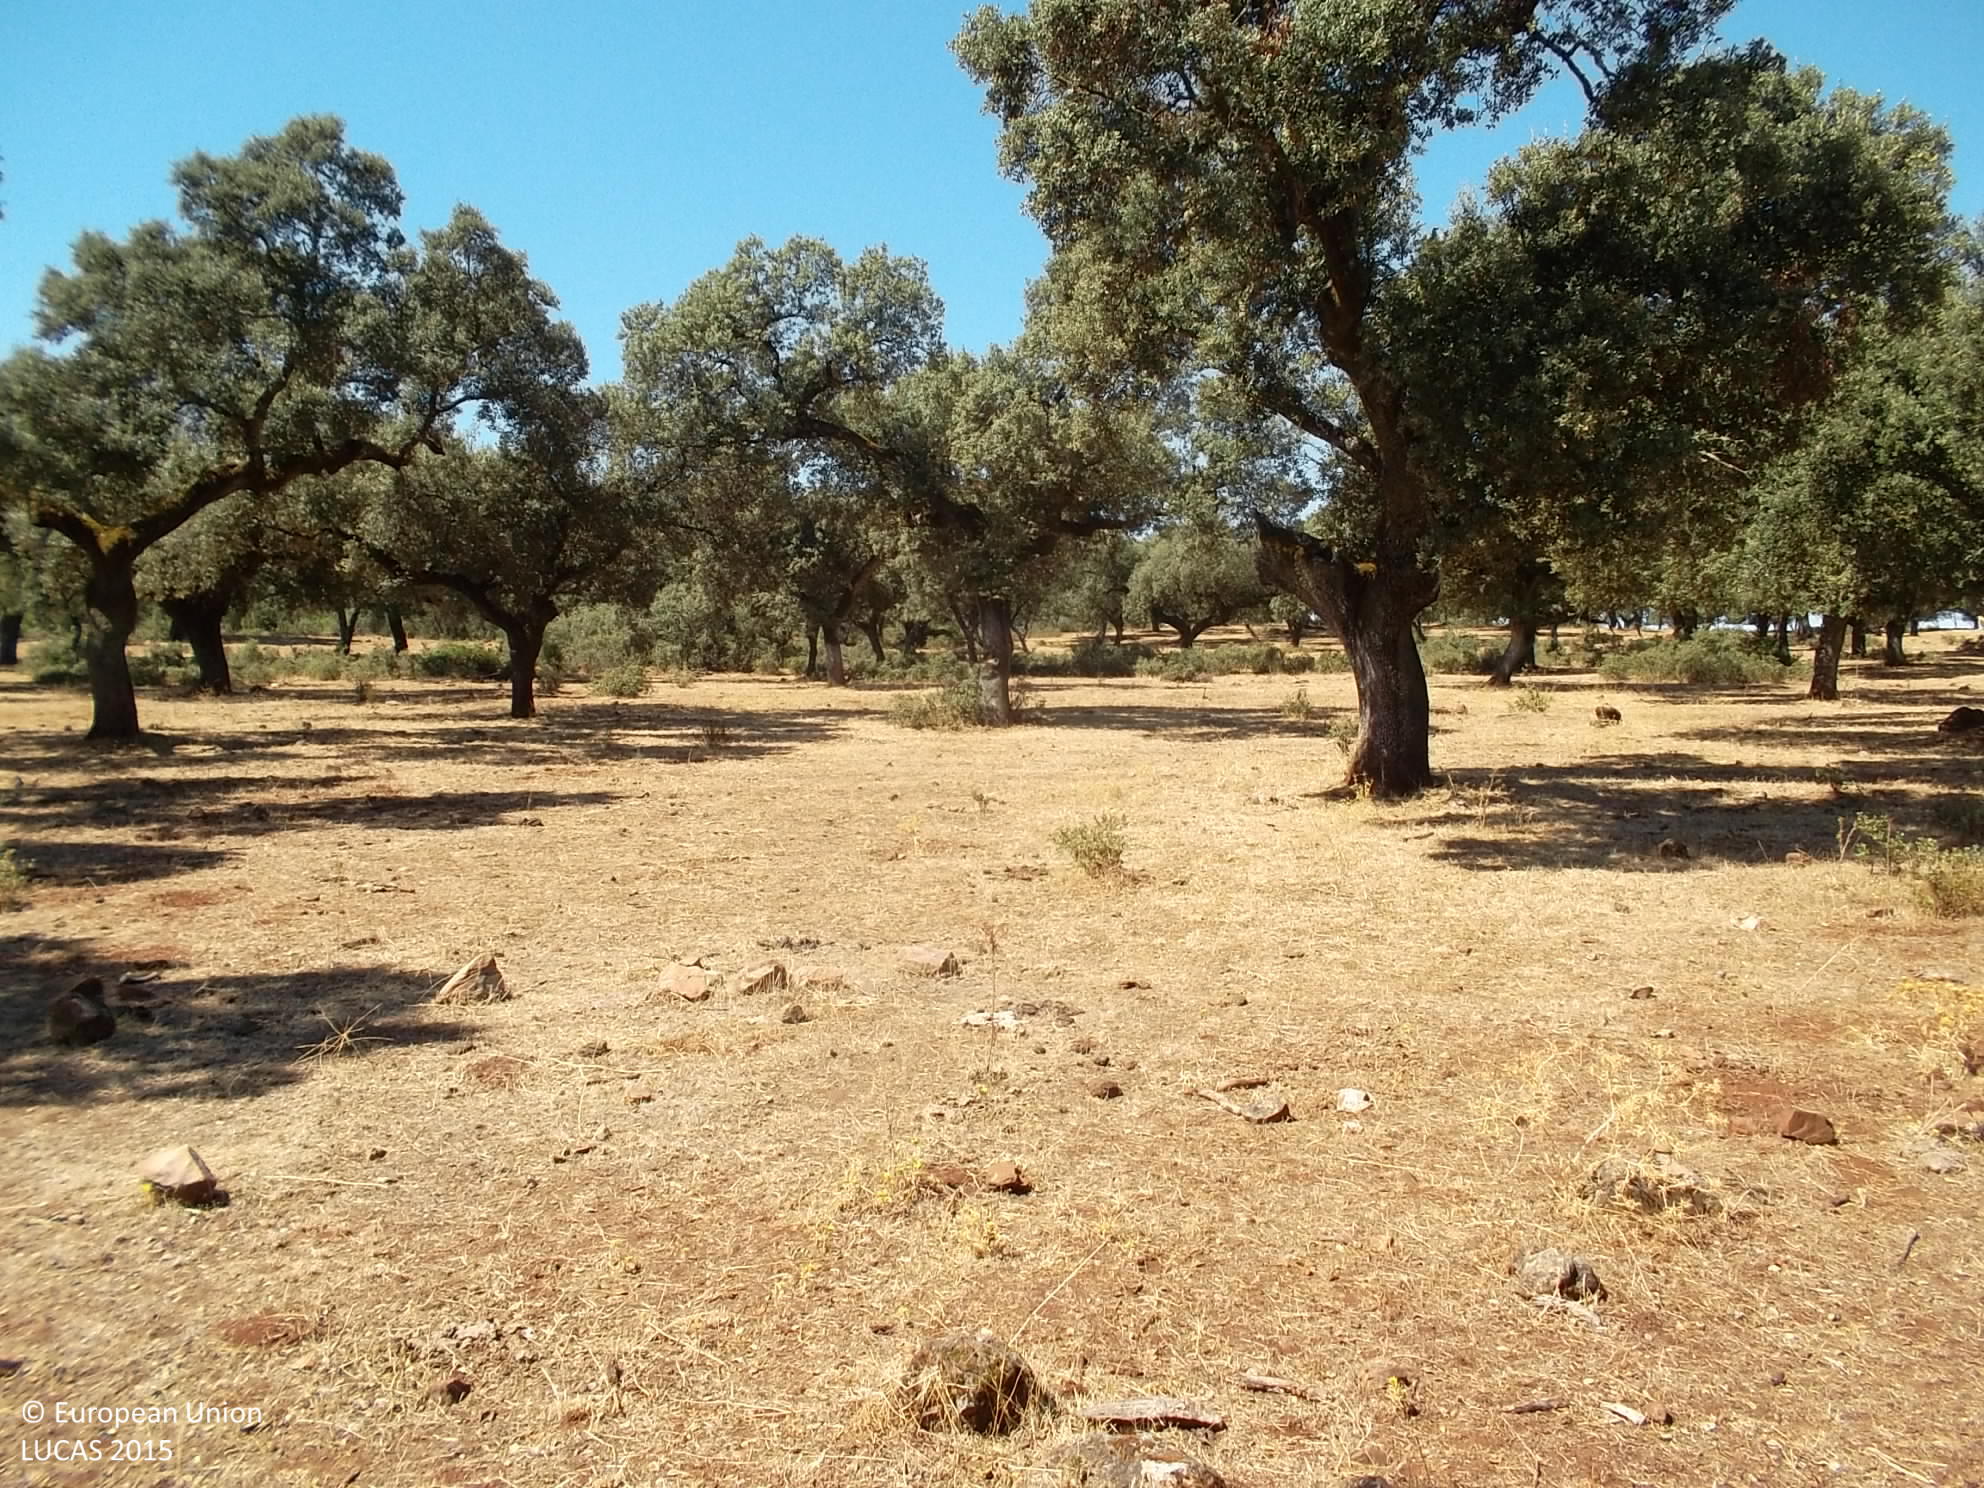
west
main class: Woodland
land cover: Broadleaved woodland
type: broadleaved evergreen forest
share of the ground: 50 - 75 %
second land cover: Grassland without tree/shrub cover
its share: 50 - 75 %
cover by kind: broadleaved forest trees 50 %, herbaceous plants 50 %
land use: Forestry
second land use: Agriculture (excluding fallow land and kitchen gardens)
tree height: > 5 m
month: August
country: ES
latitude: 38.2388
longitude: -6.6756
